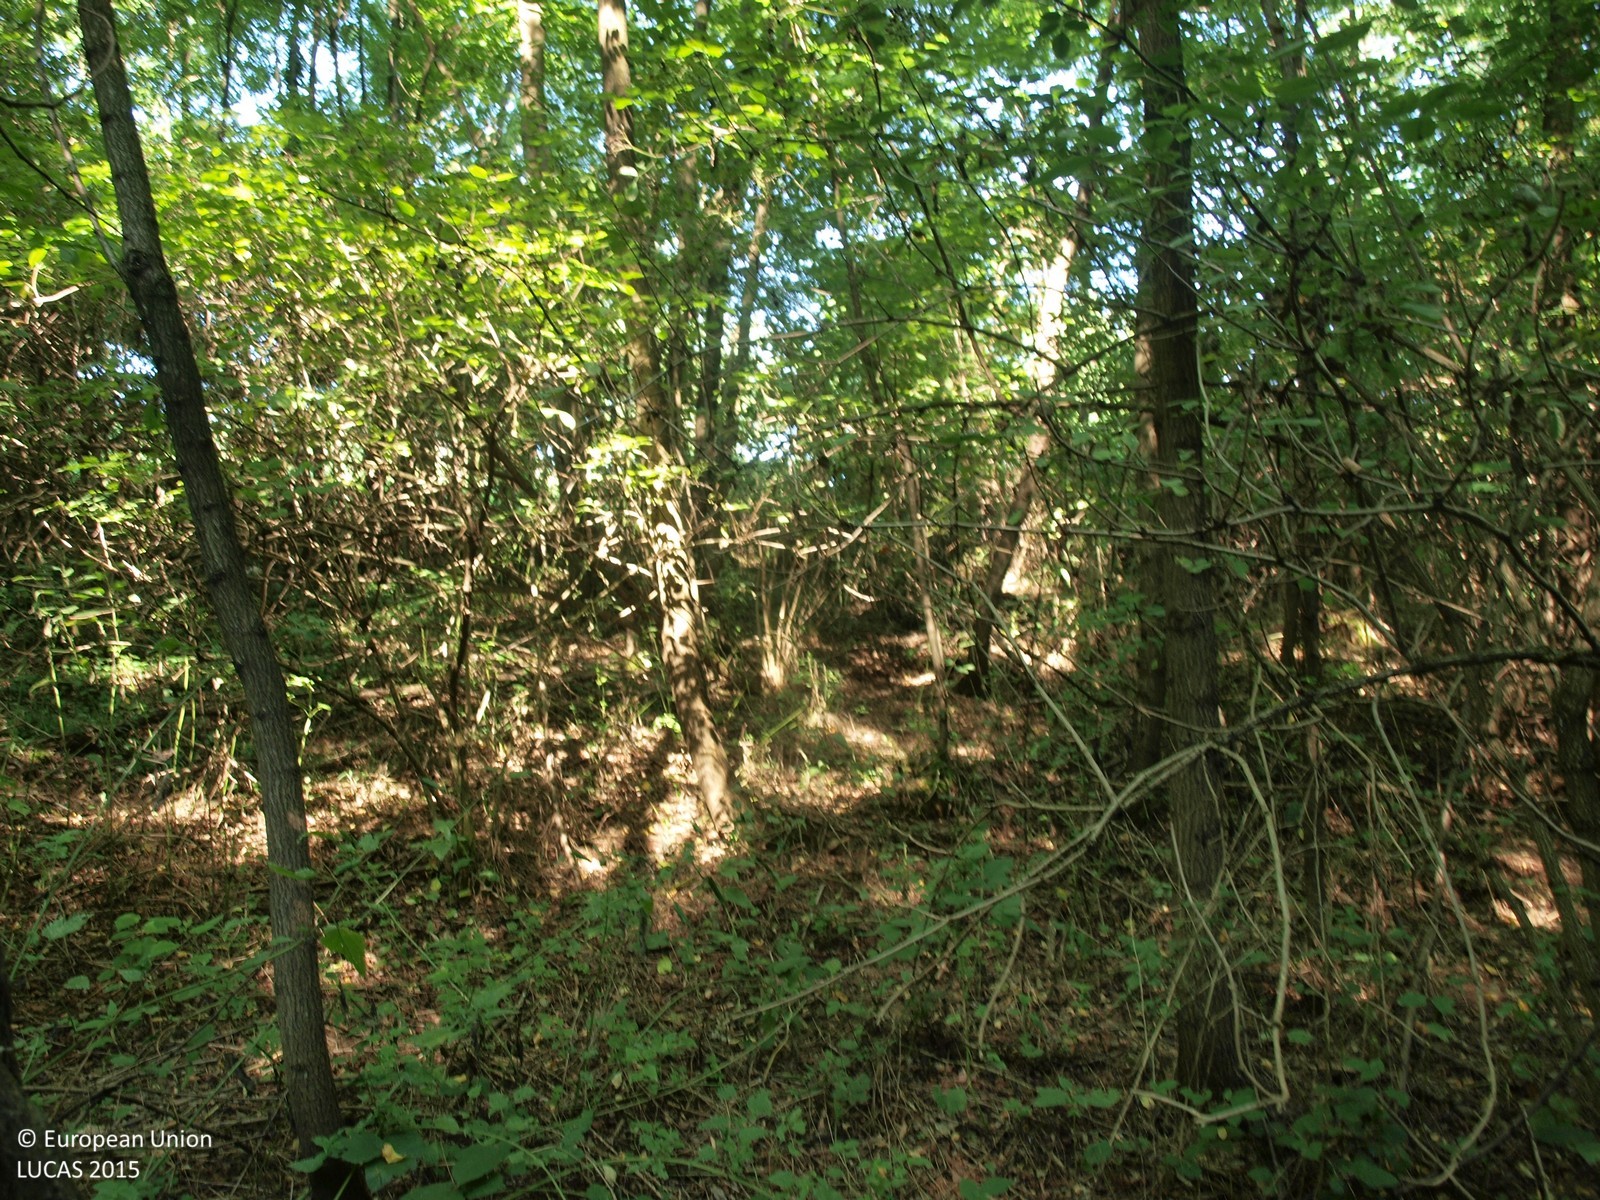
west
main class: Woodland
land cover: Broadleaved woodland
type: mesophytic deciduous forest
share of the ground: > 75 %
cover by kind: broadleaved forest trees 100 %
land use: Forestry
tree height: > 5 m
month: August
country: HR
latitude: 45.9795
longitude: 16.3886
